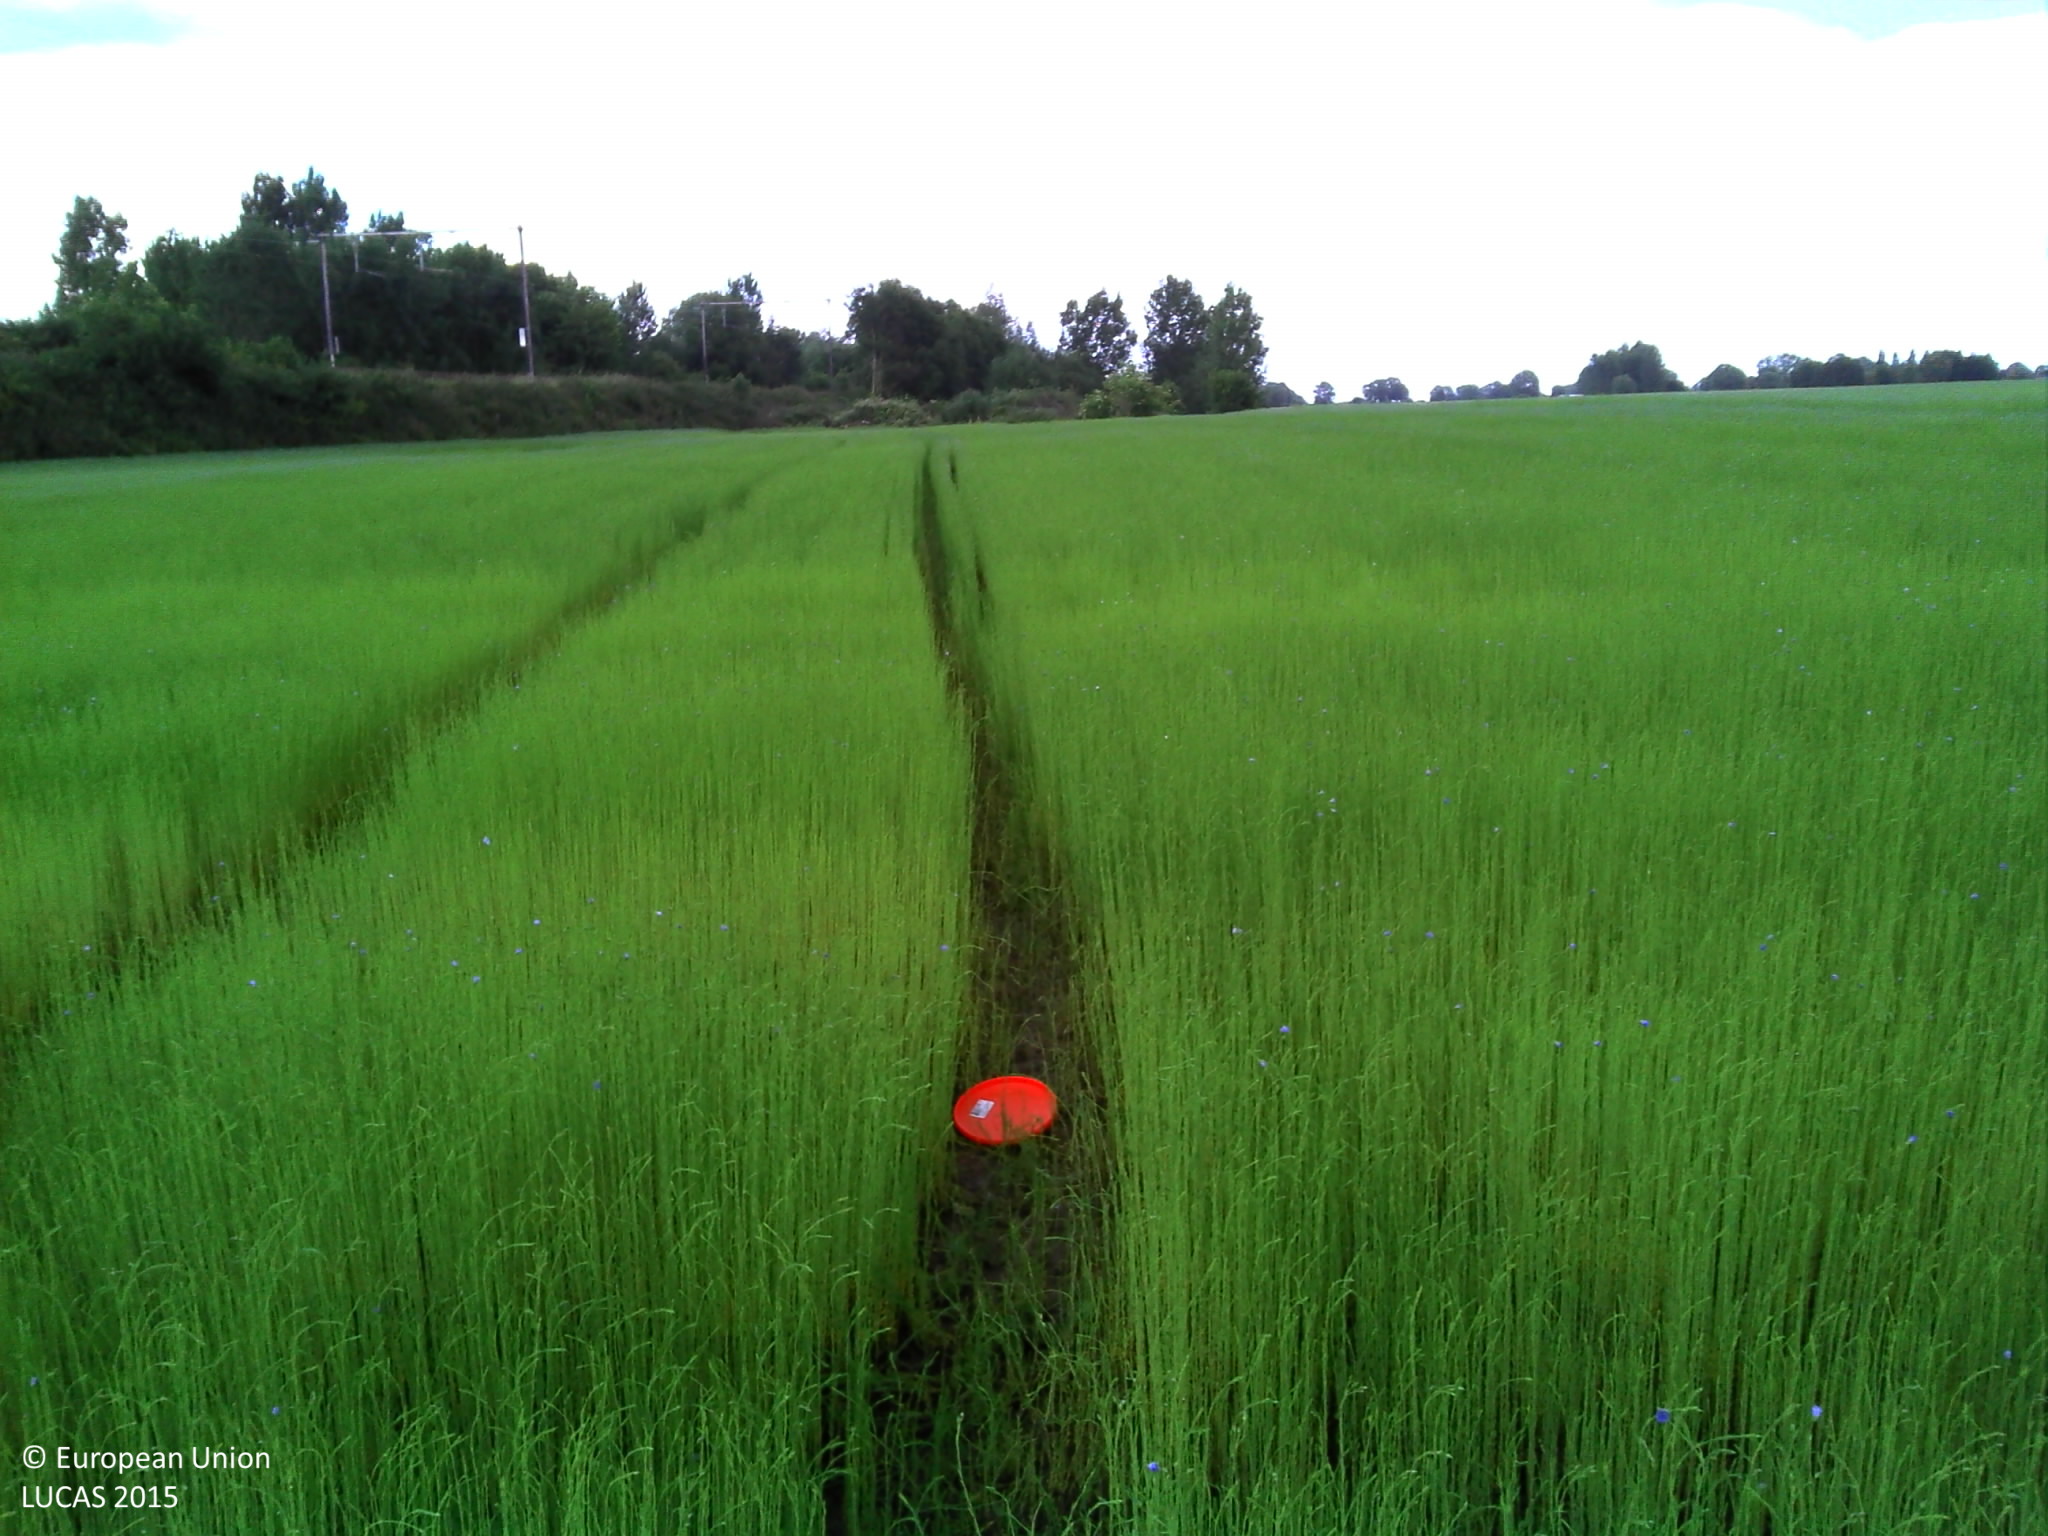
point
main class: Cropland
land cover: Other fibre and oleaginous crops
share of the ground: > 75 %
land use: Agriculture (excluding fallow land and kitchen gardens)
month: June
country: BE
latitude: 50.5504
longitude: 4.0243
